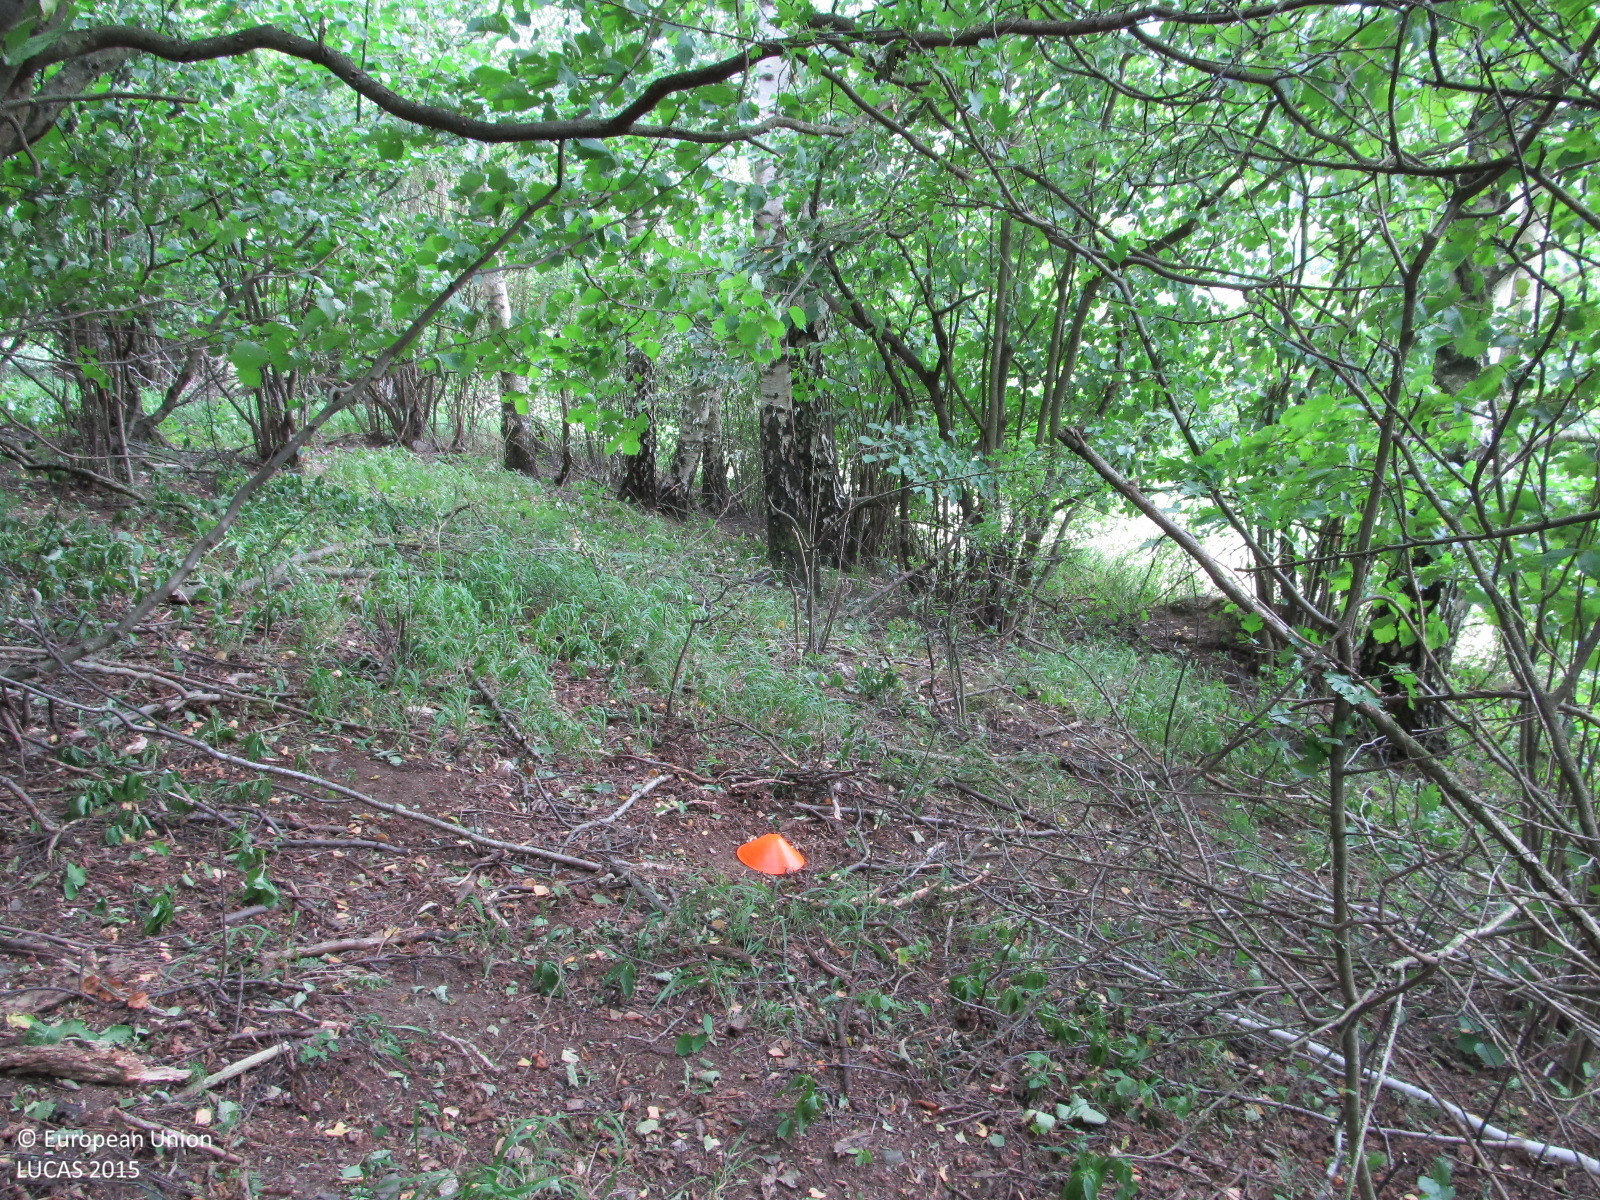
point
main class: Woodland
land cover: Broadleaved woodland
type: non-riverine alder, birch or aspen forest
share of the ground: > 75 %
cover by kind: broadleaved forest trees 75 %, herbaceous plants 15 %, shrubs 5 %, unconsolidated bare surface 5 %
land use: Forestry
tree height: < 5 m
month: July
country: AT
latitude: 48.4328
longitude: 15.4223
